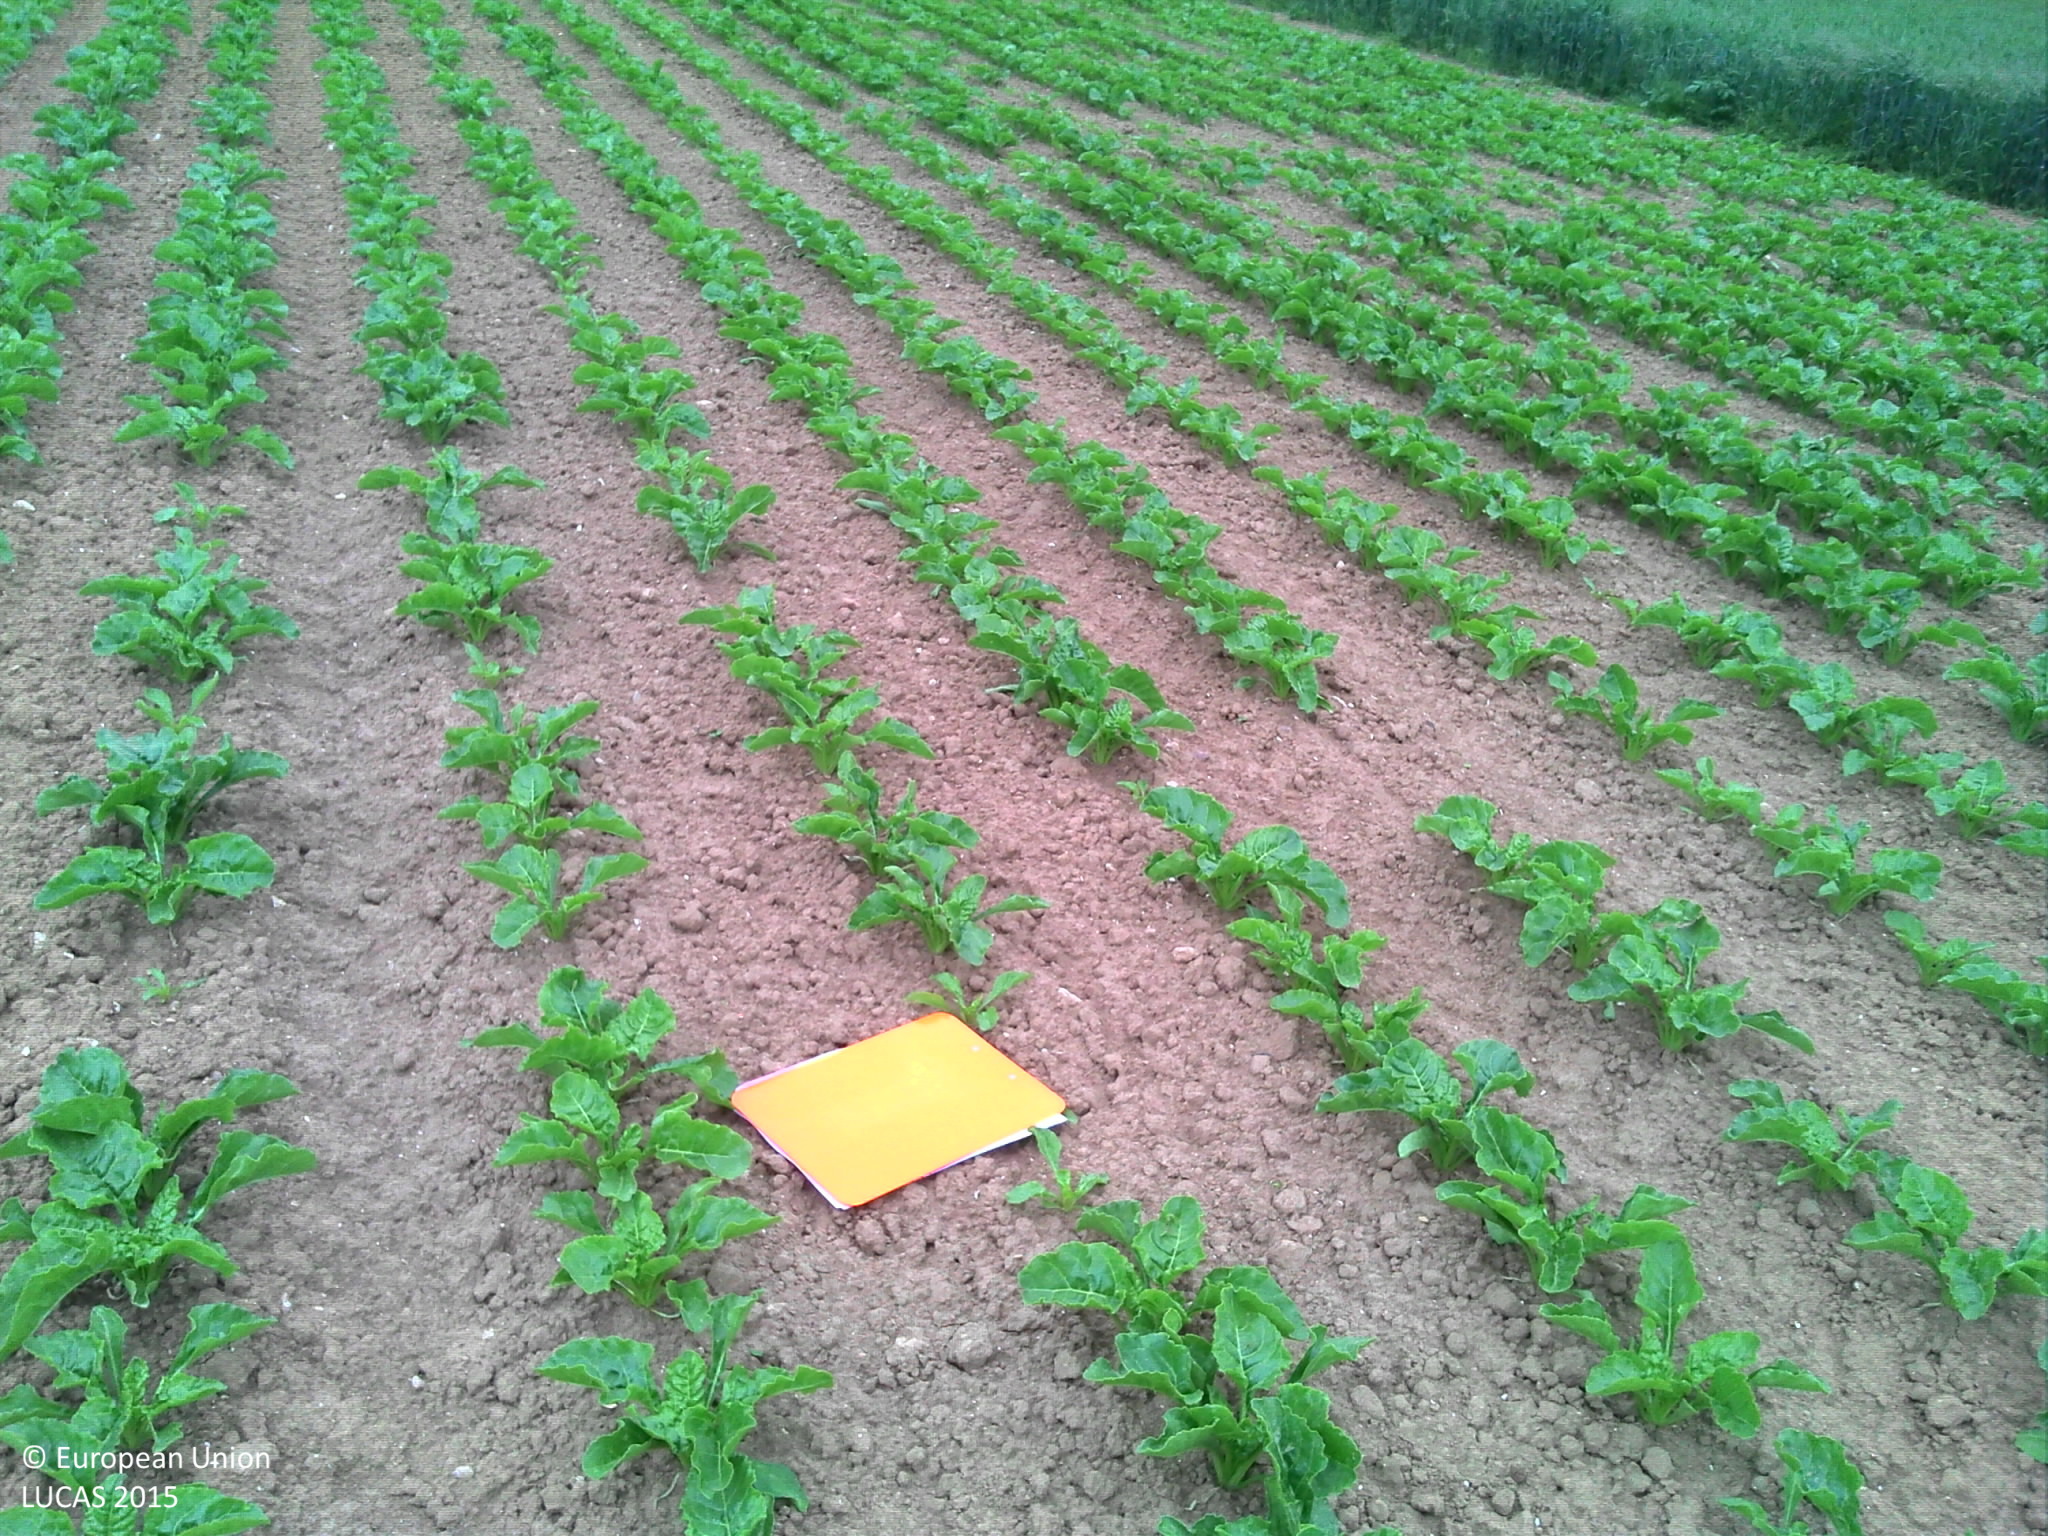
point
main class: Cropland
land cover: Sugar beet
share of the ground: 25 - 50 %
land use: Agriculture (excluding fallow land and kitchen gardens)
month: May
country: FR
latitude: 49.2963
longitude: -0.3341
